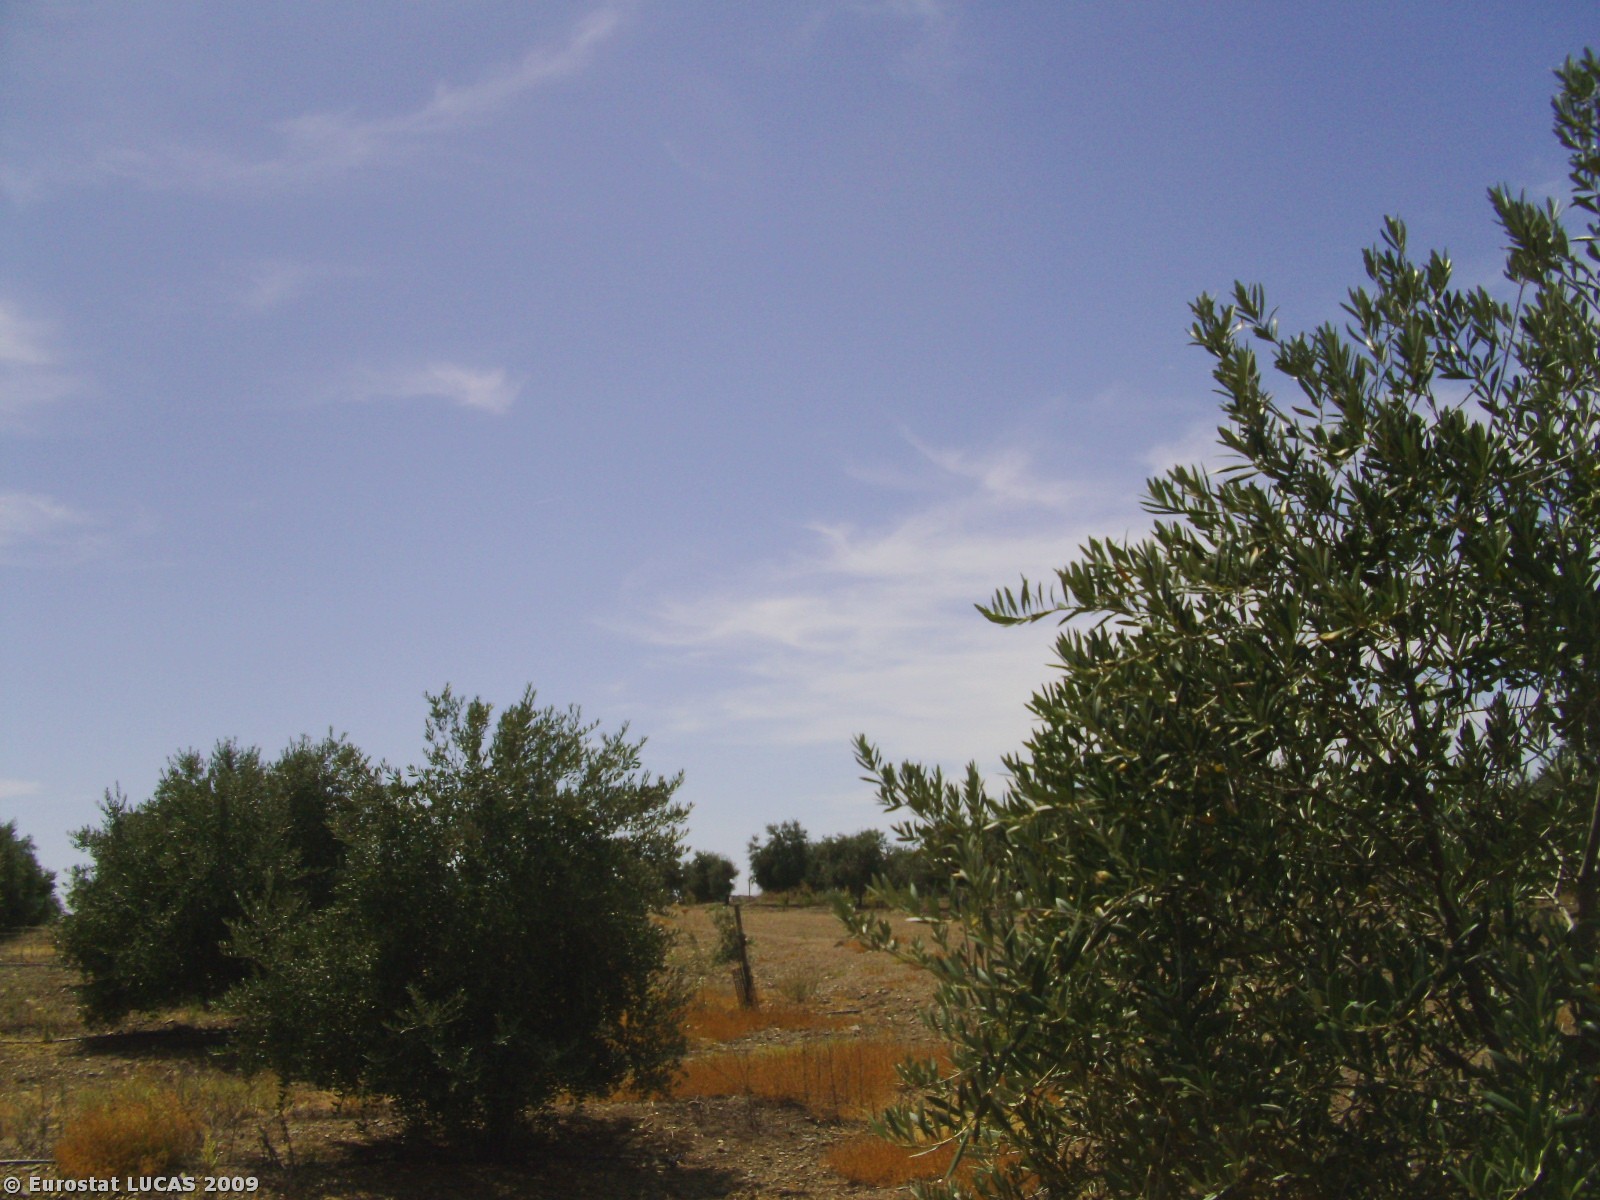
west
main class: Cropland
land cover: Olive groves
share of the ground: 50 - 75 %
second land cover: Bare land
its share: 25 - 50 %
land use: Agriculture (excluding fallow land and kitchen gardens)
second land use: Fallow land
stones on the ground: < 10 %
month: August
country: PT
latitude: 38.0832
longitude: -7.7315
